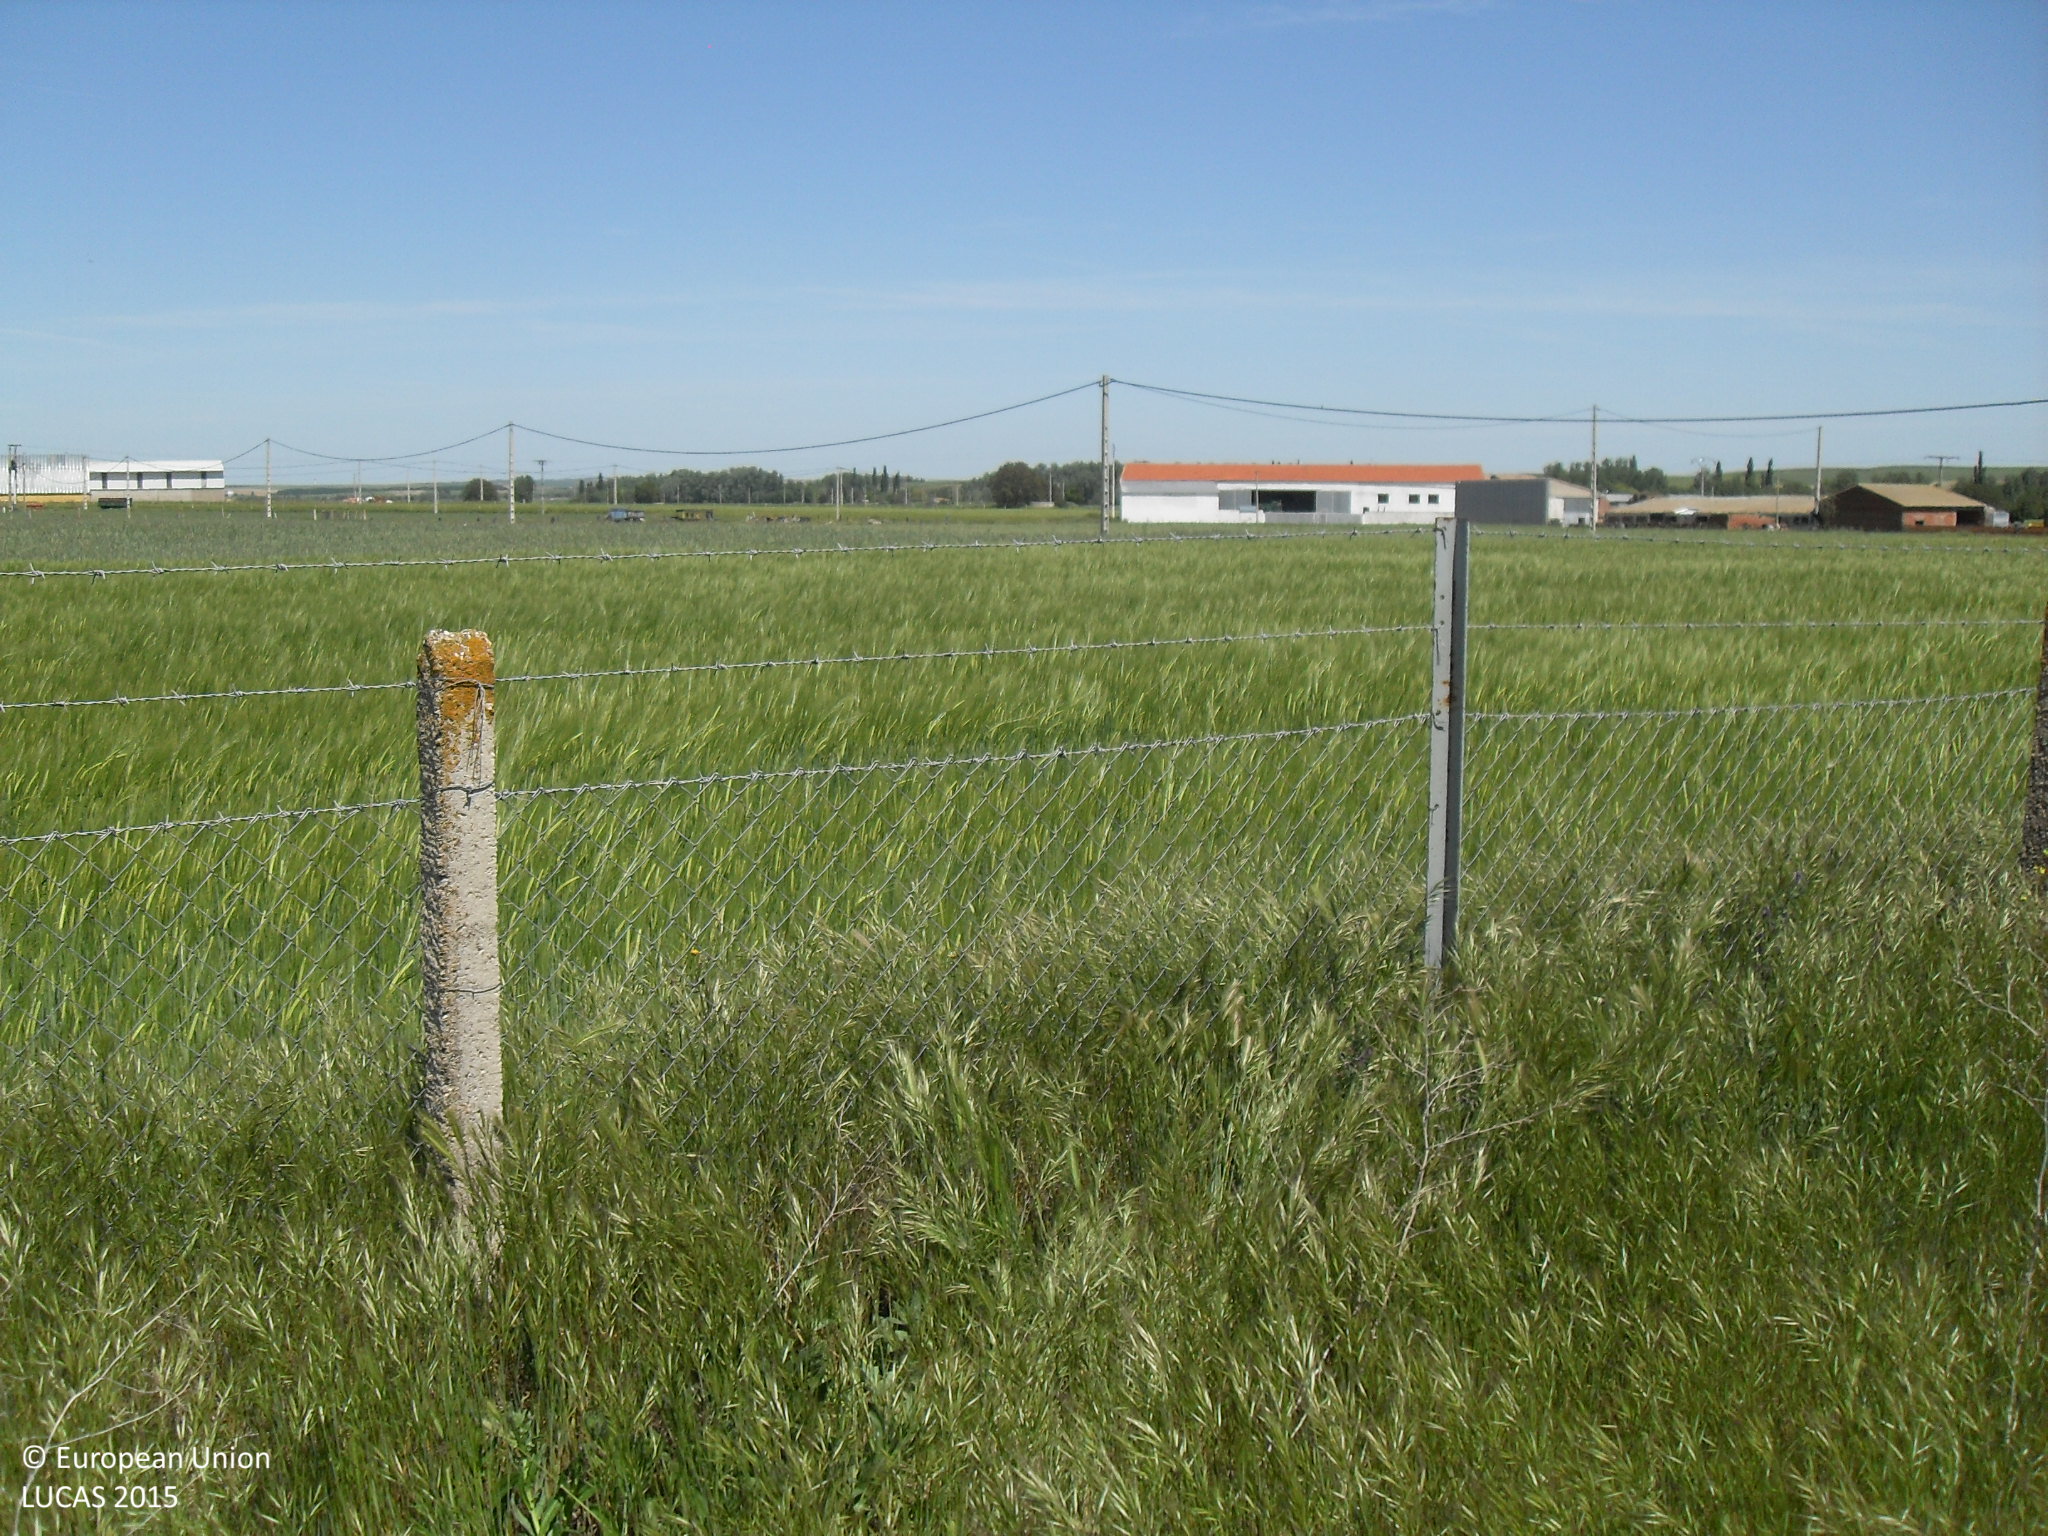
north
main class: Grassland
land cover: Grassland without tree/shrub cover
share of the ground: > 75 %
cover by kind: herbaceous plants 100 %
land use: Agriculture (excluding fallow land and kitchen gardens)
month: May
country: ES
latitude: 40.8503
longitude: -5.3595
